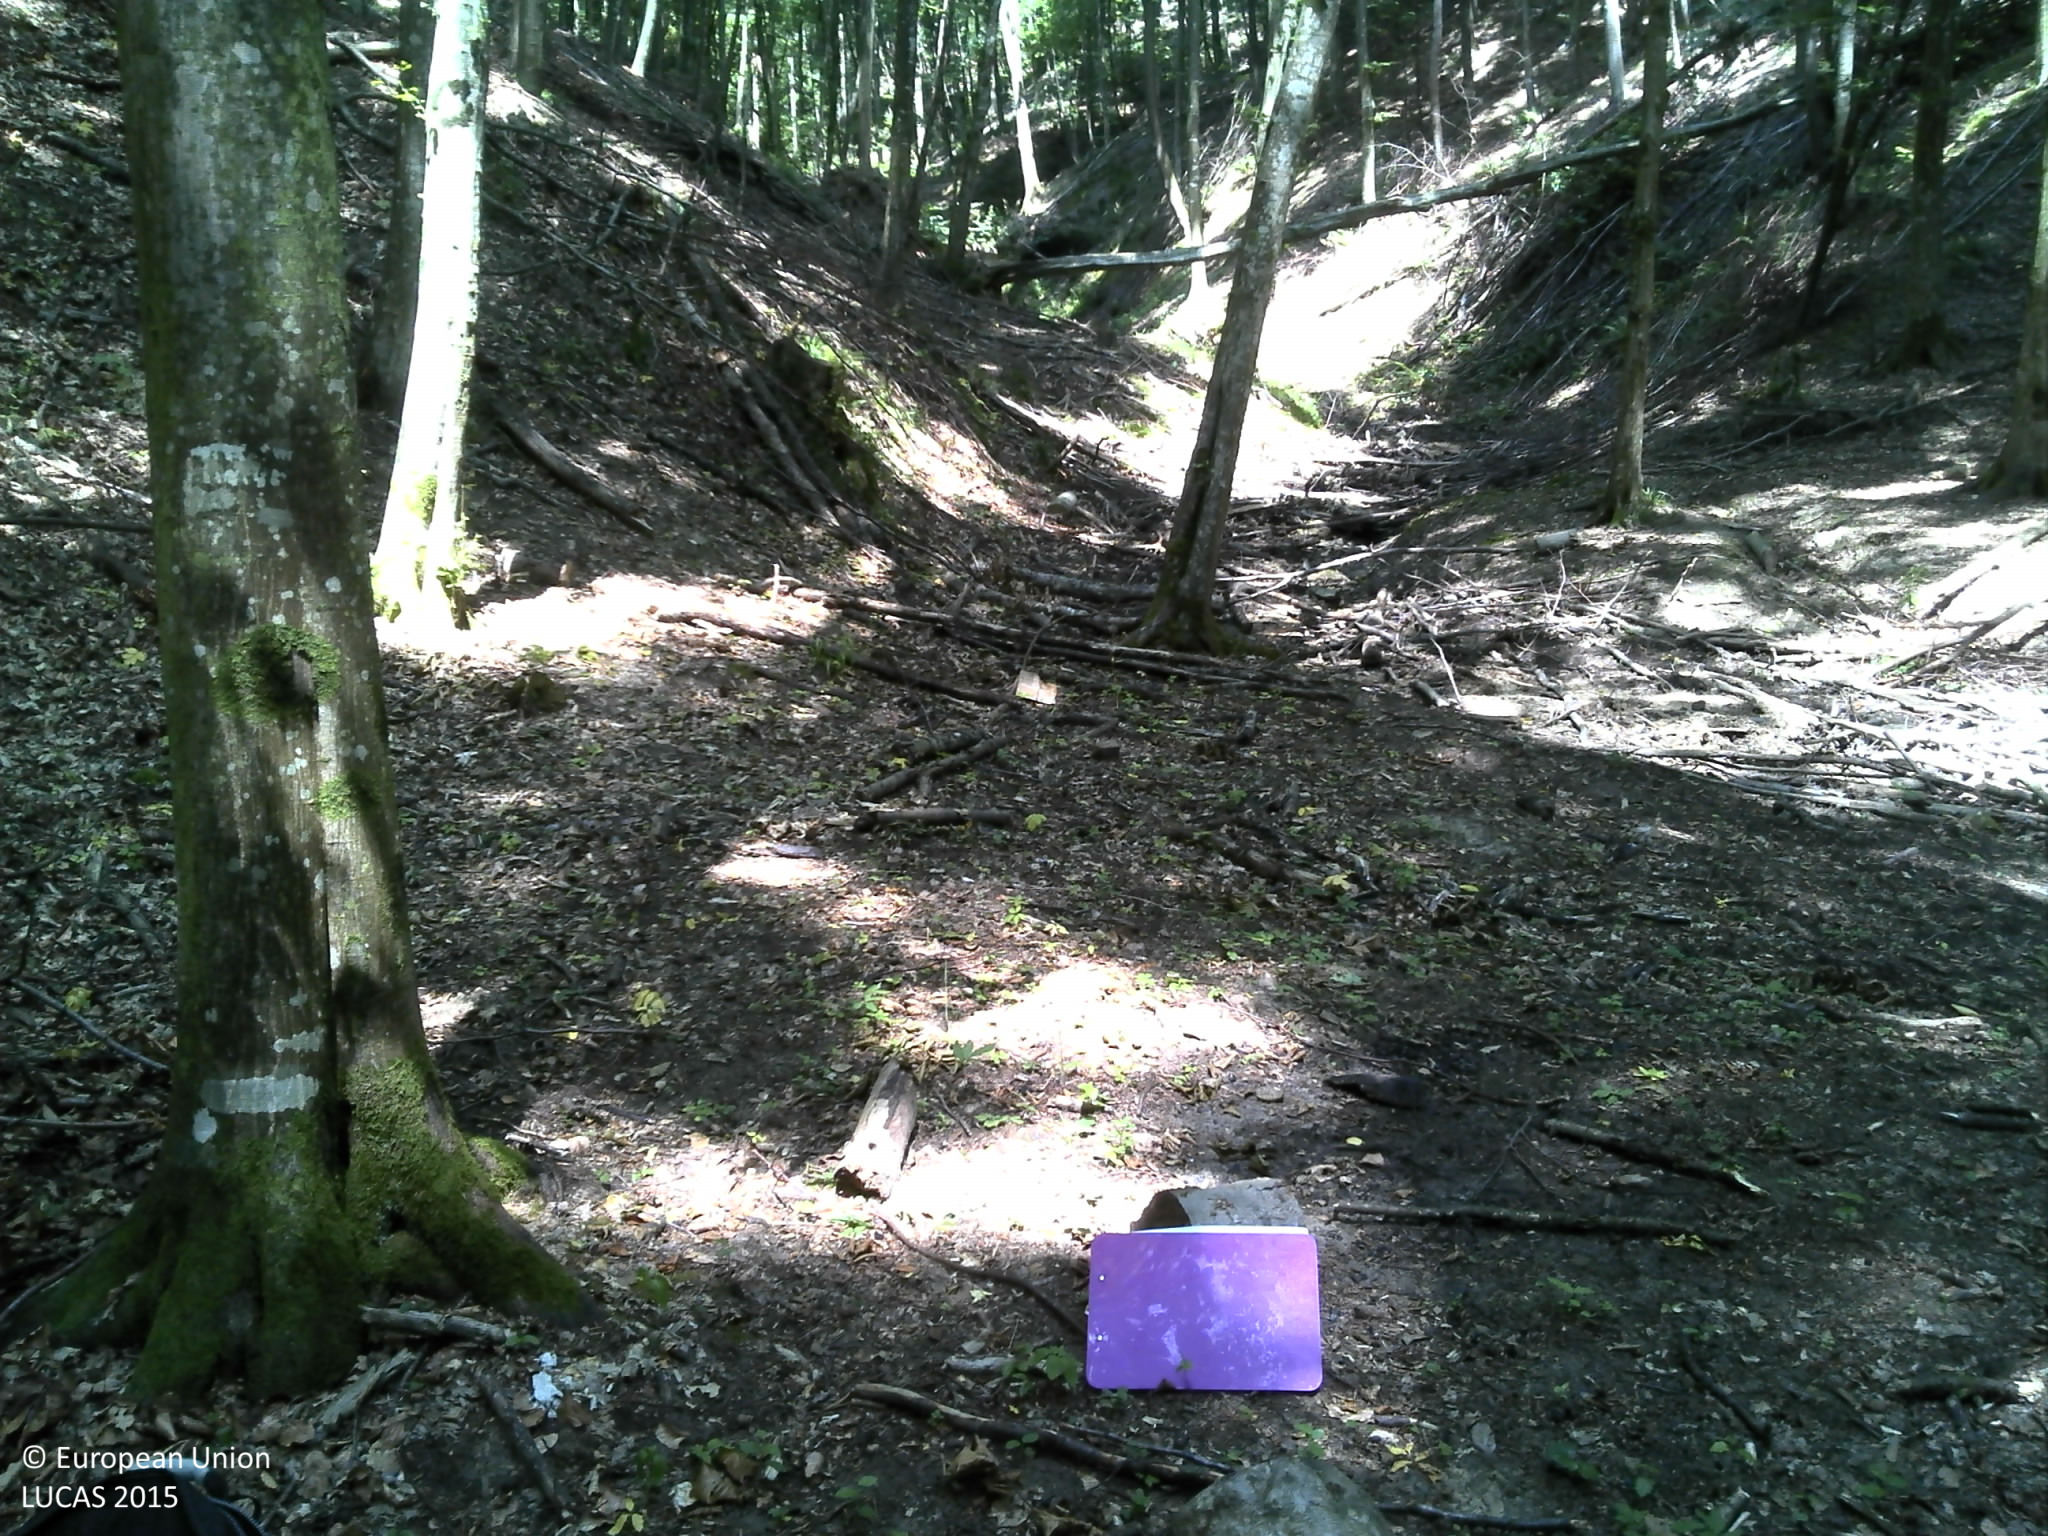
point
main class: Woodland
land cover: Broadleaved woodland
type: acidophilous oak and oak-birch forest
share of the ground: > 75 %
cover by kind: broadleaved forest trees 90 %, shrubs 5 %, herbaceous plants 5 %
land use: Forestry
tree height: > 5 m
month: July
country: HR
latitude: 45.6915
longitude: 16.6639
